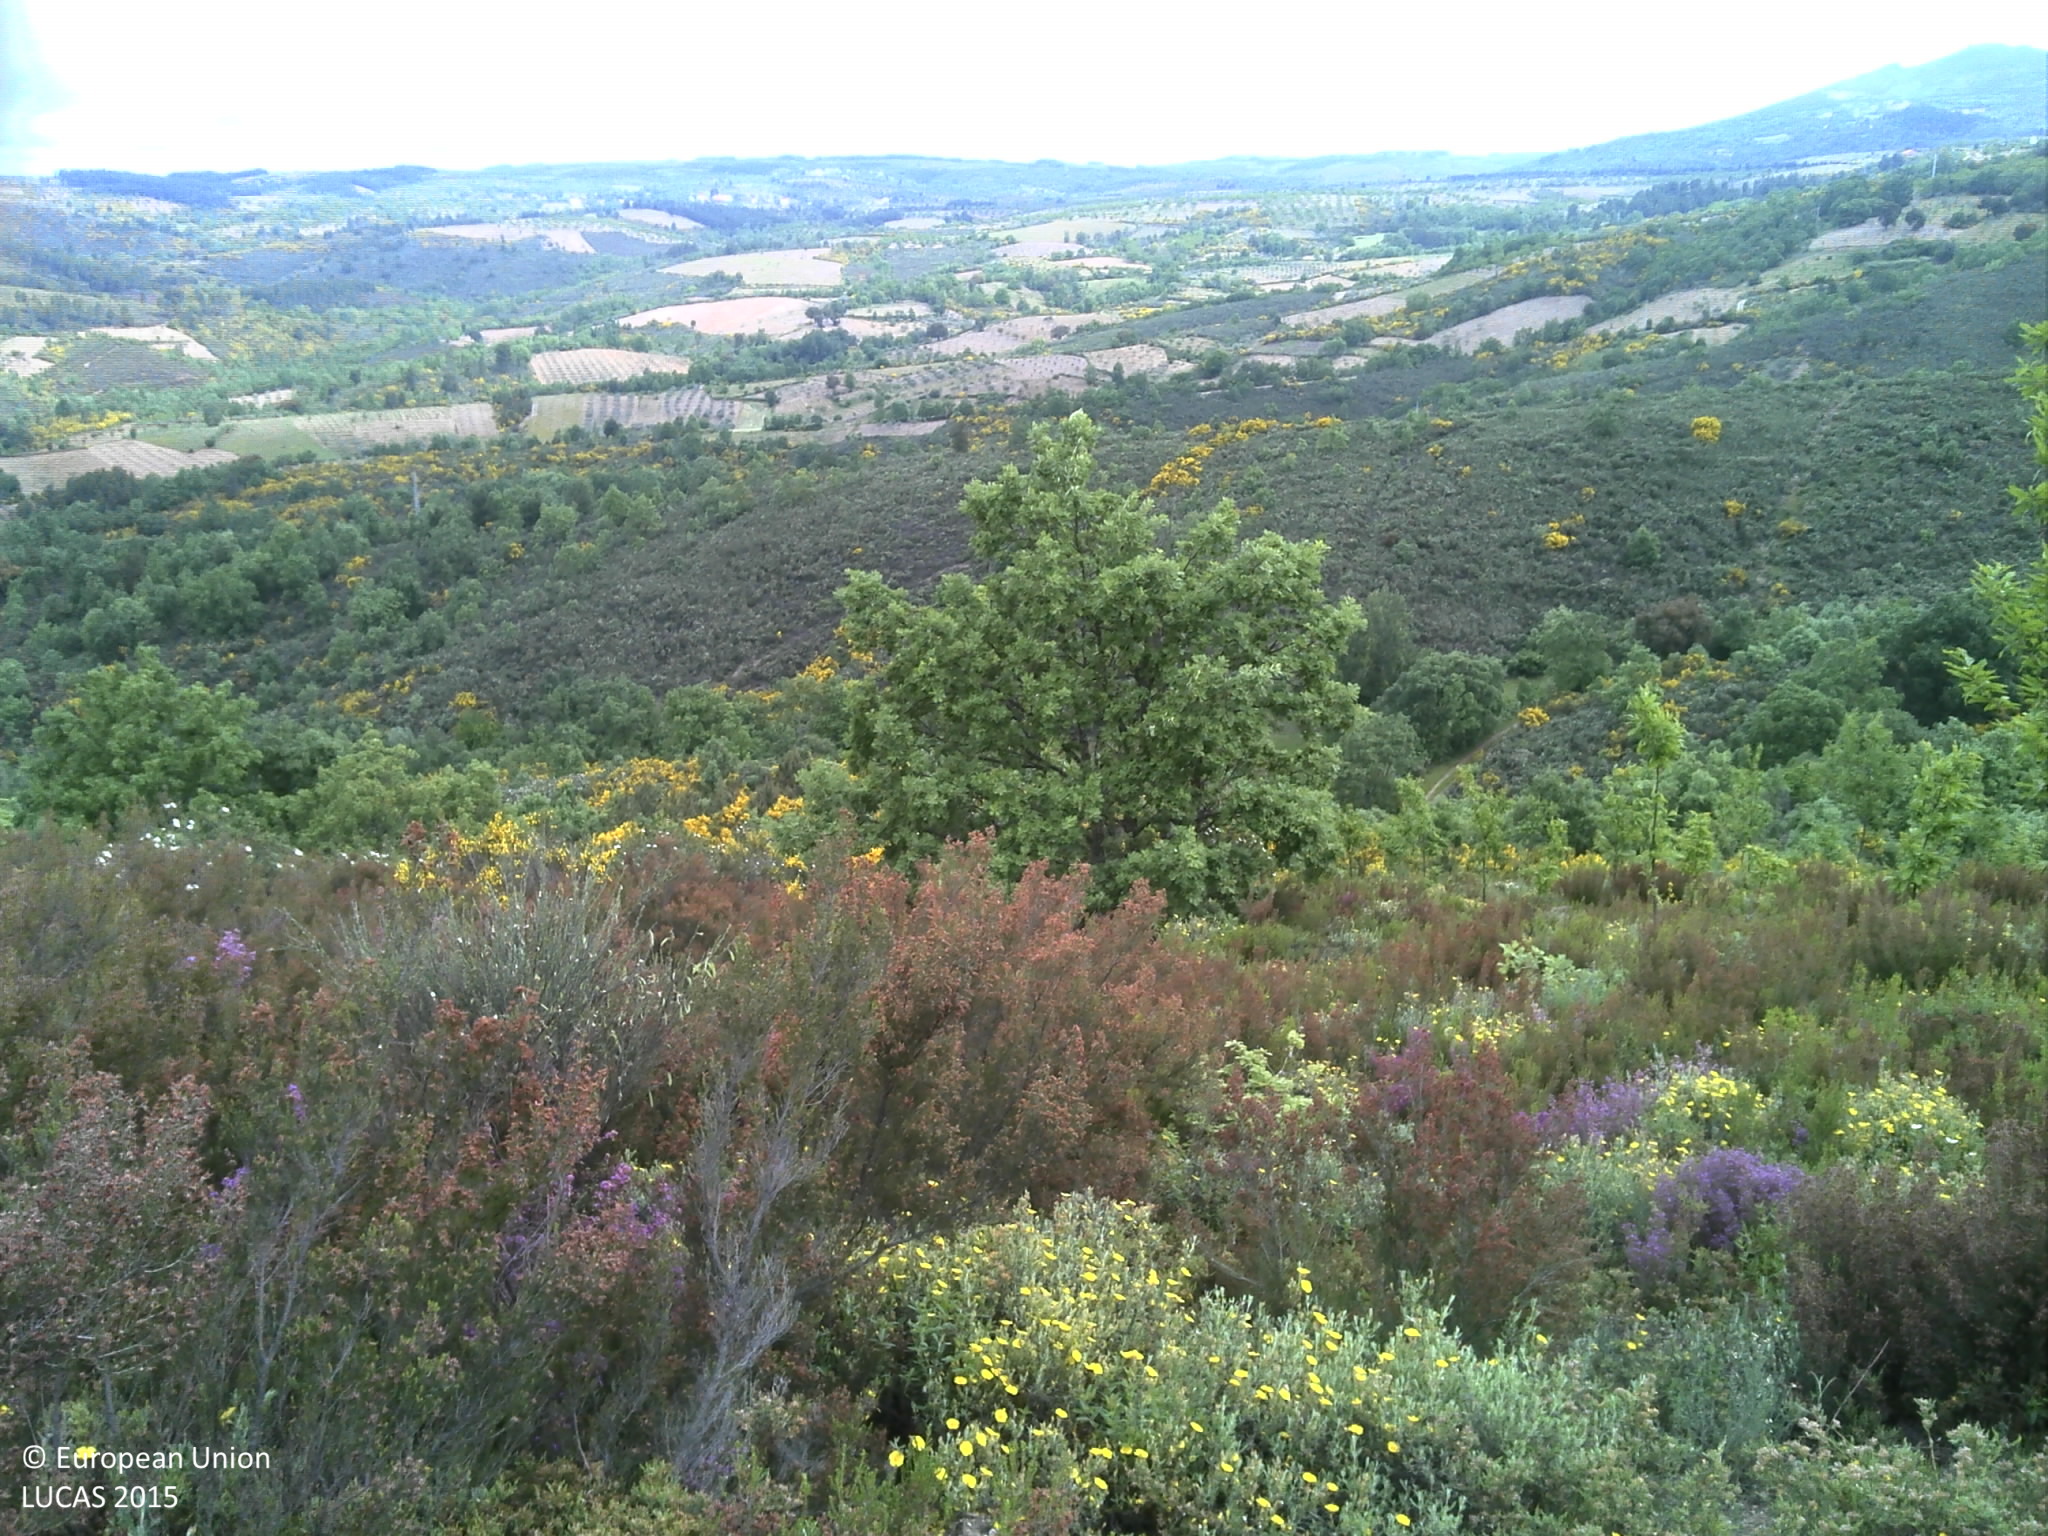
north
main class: Shrubland
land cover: Shrubland with sparse tree cover
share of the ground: > 75 %
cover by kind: shrubs 90 %, broadleaved forest trees 5 %, unconsolidated bare surface 5 %
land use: Abandoned areas
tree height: > 5 m
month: May
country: PT
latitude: 41.6178
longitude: -6.9529
